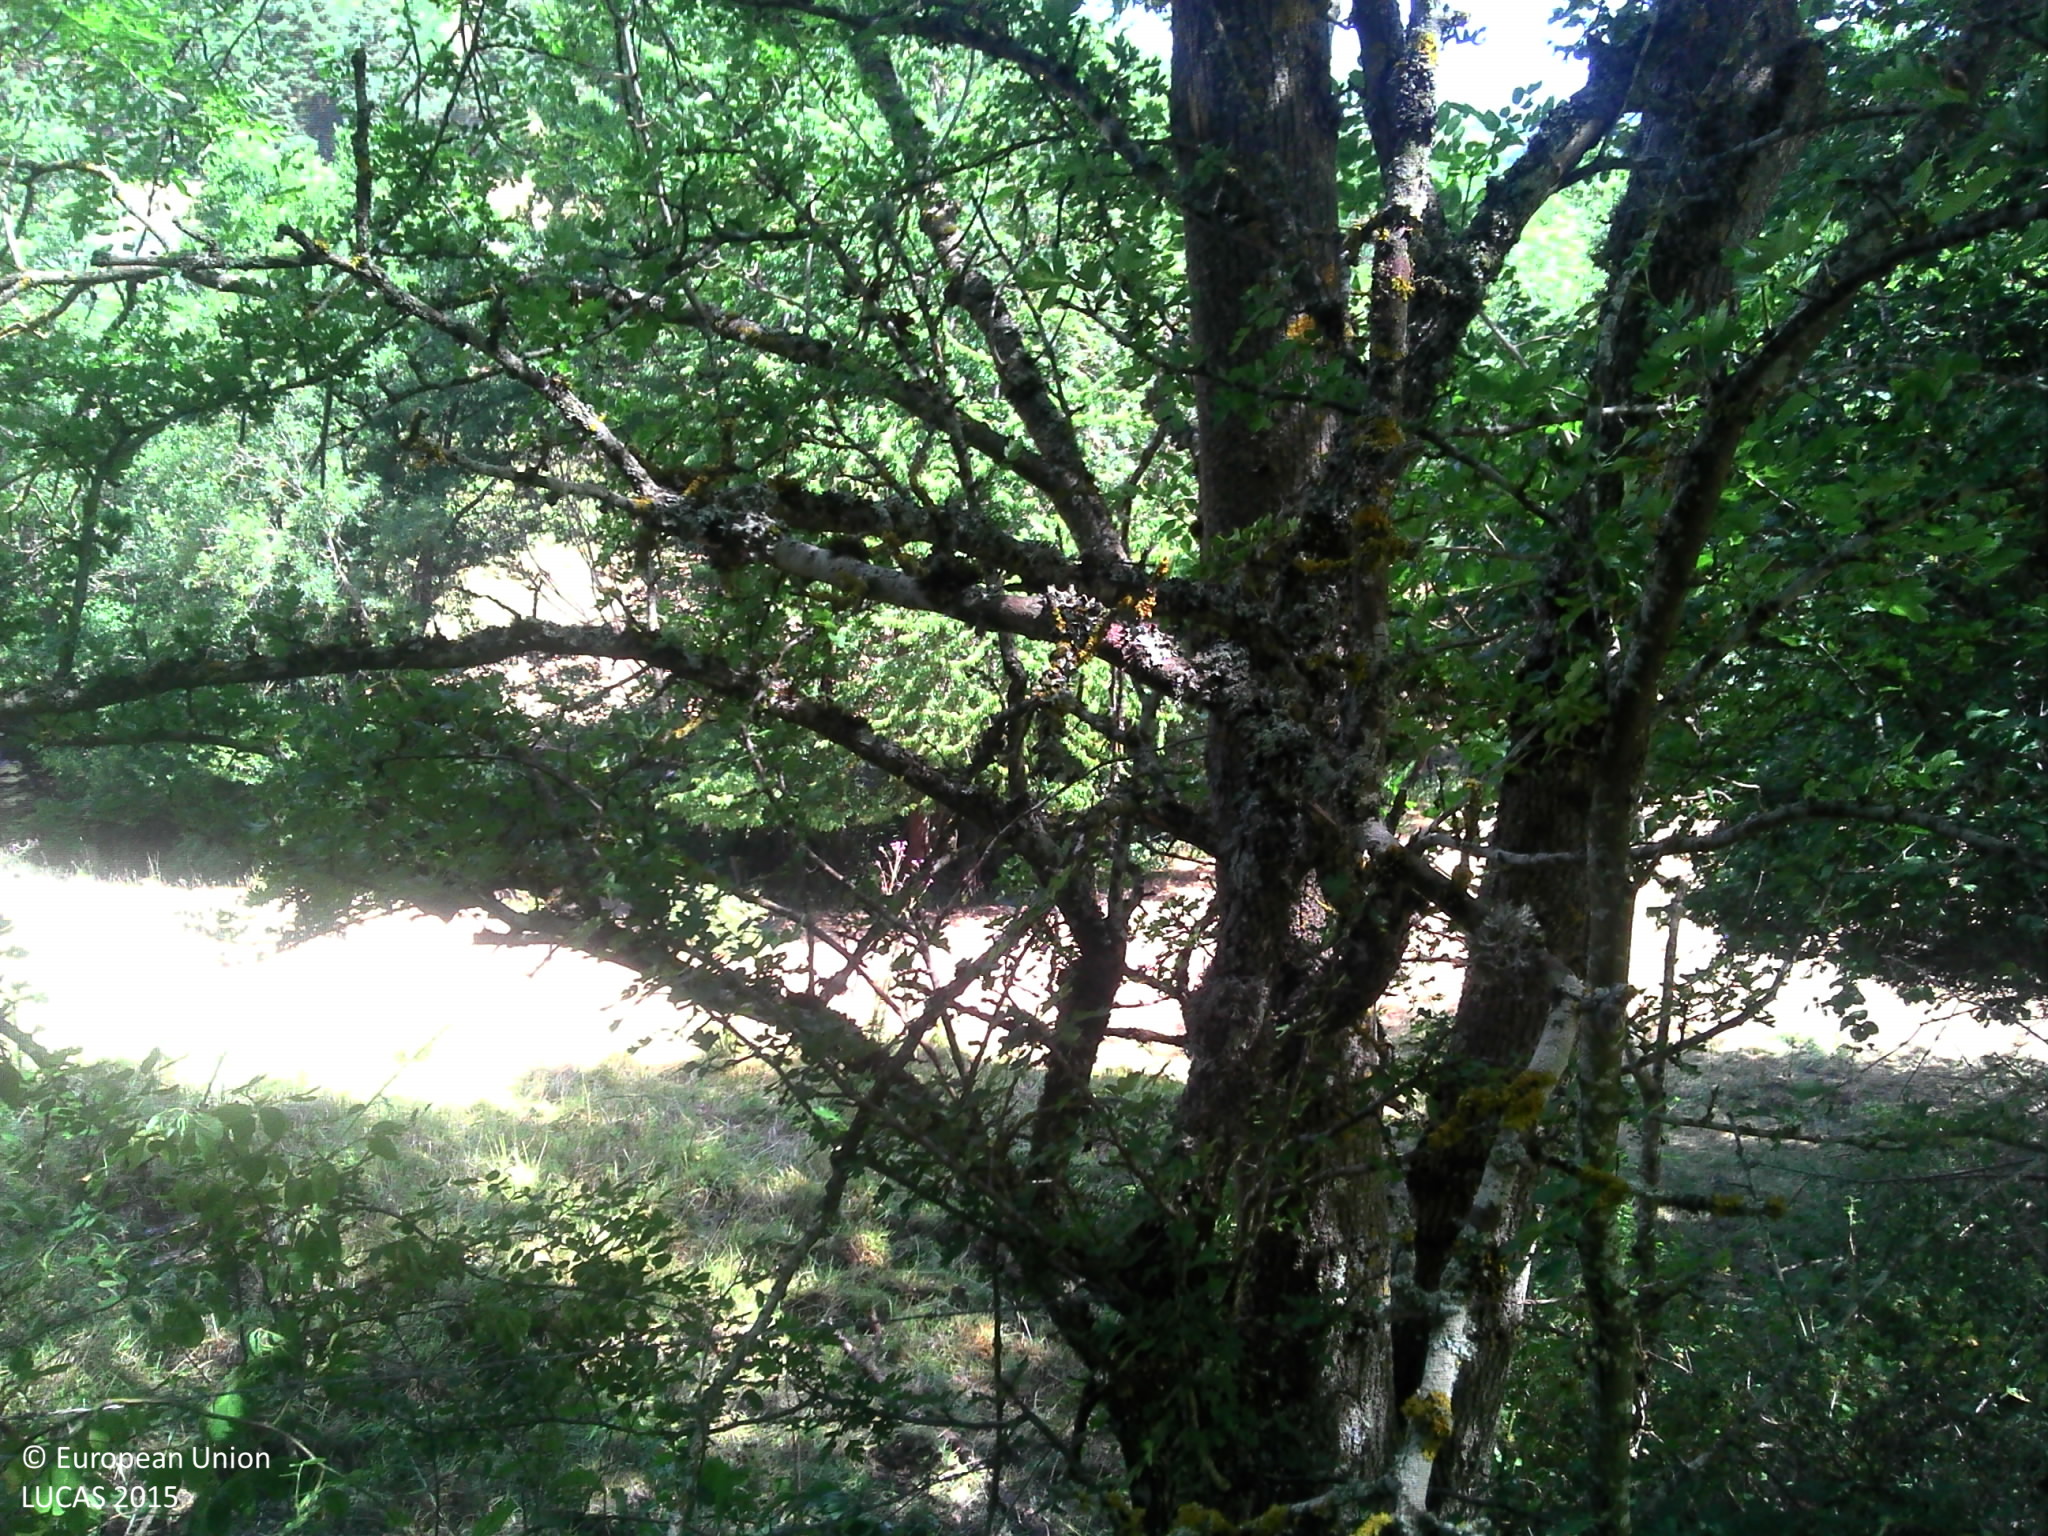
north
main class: Woodland
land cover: Broadleaved woodland
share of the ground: > 75 %
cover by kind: broadleaved forest trees 60 %, shrubs 30 %, herbaceous plants 10 %
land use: Semi-natural and natural areas not in use
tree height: > 5 m
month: July
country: FR
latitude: 45.1432
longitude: 2.9687
